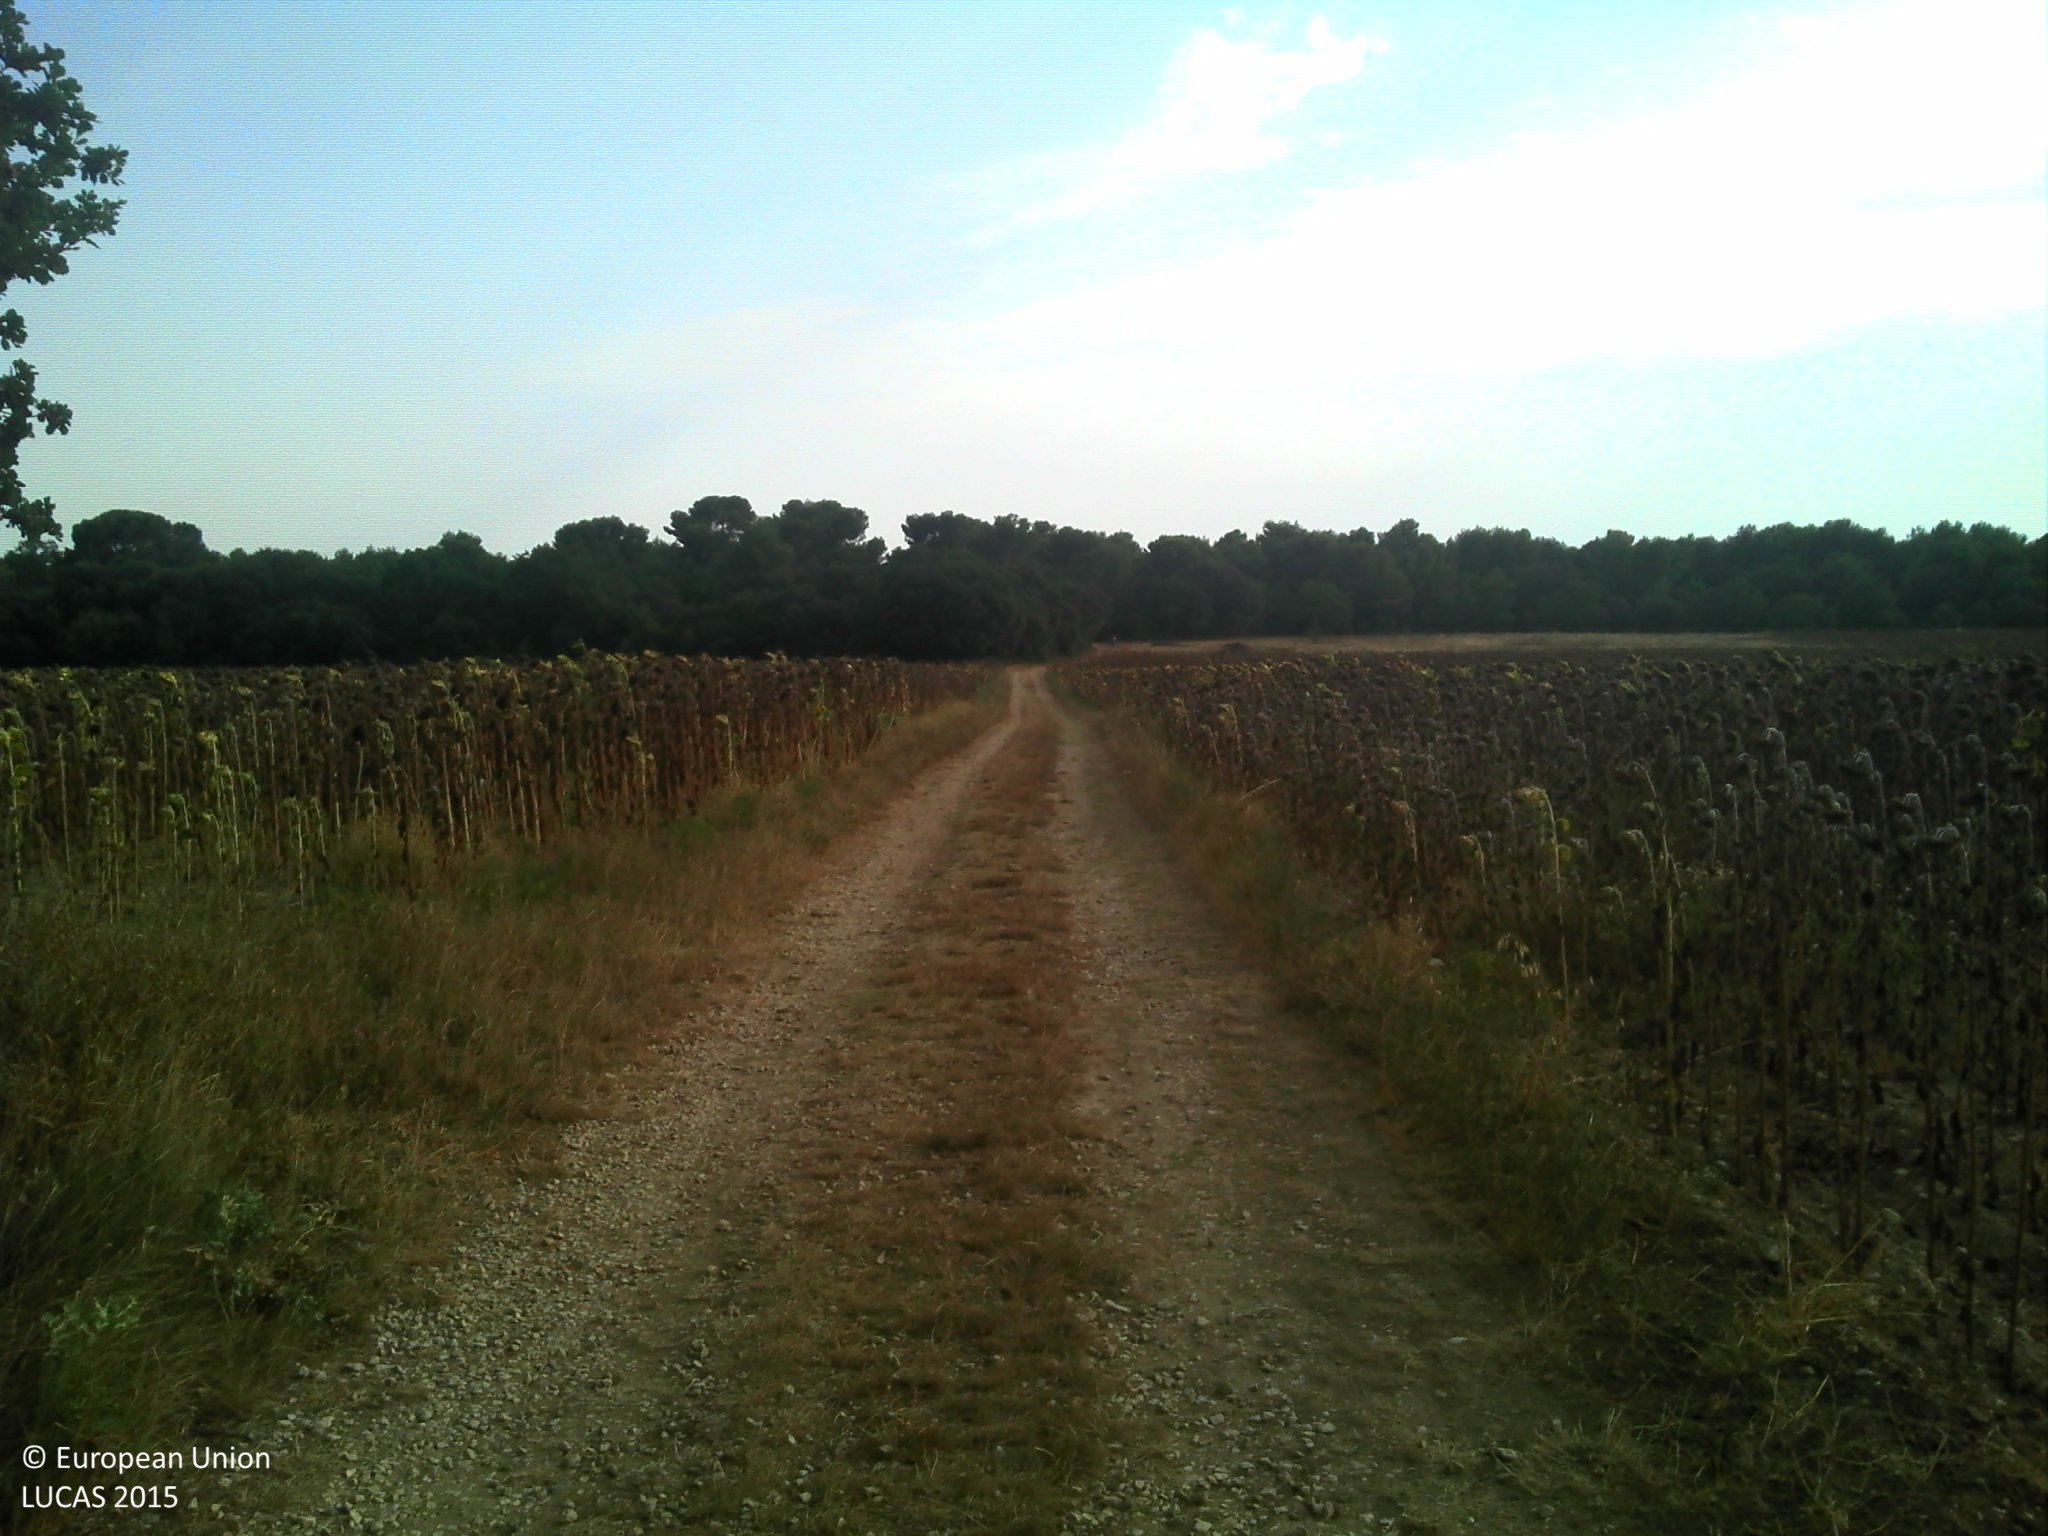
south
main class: Cropland
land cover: Sunflower
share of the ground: 25 - 50 %
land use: Agriculture (excluding fallow land and kitchen gardens)
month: August
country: FR
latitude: 43.5977
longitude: 5.3890
